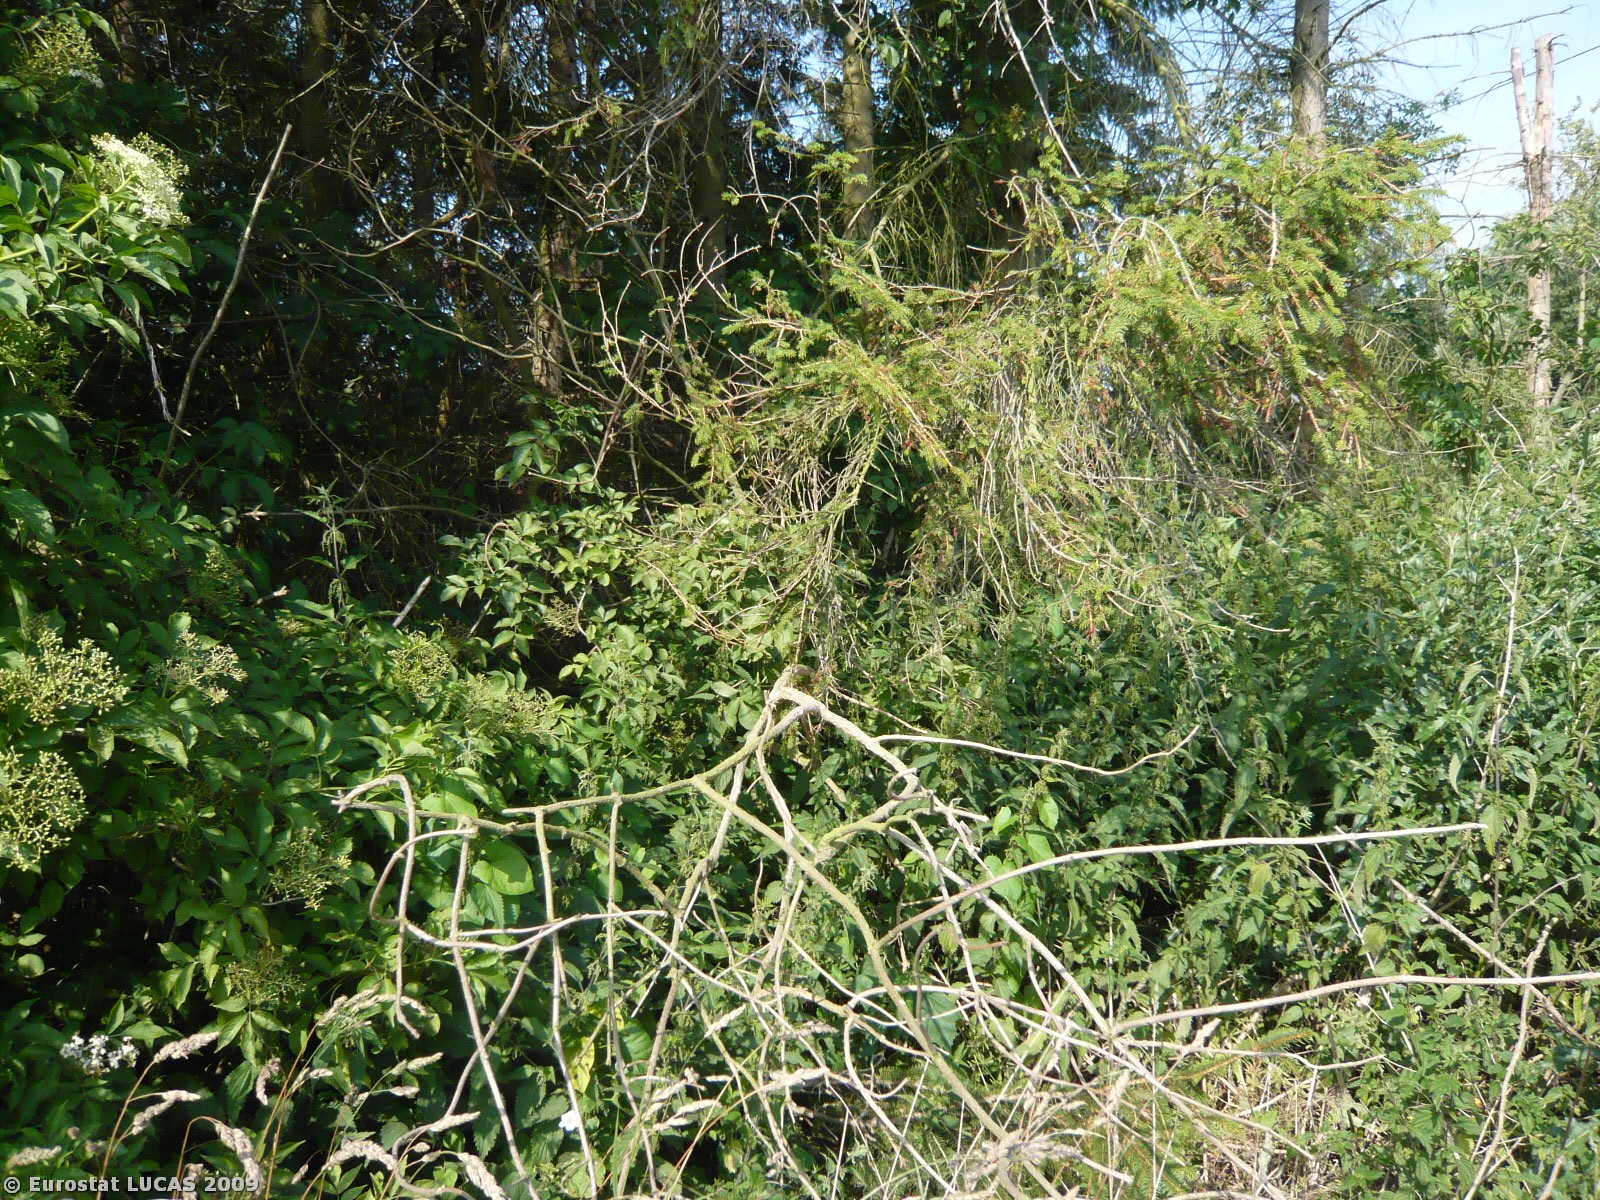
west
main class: Woodland
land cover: Coniferous woodland
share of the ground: > 75 %
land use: Unused
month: July
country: DK
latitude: 55.6358
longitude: 11.7935
